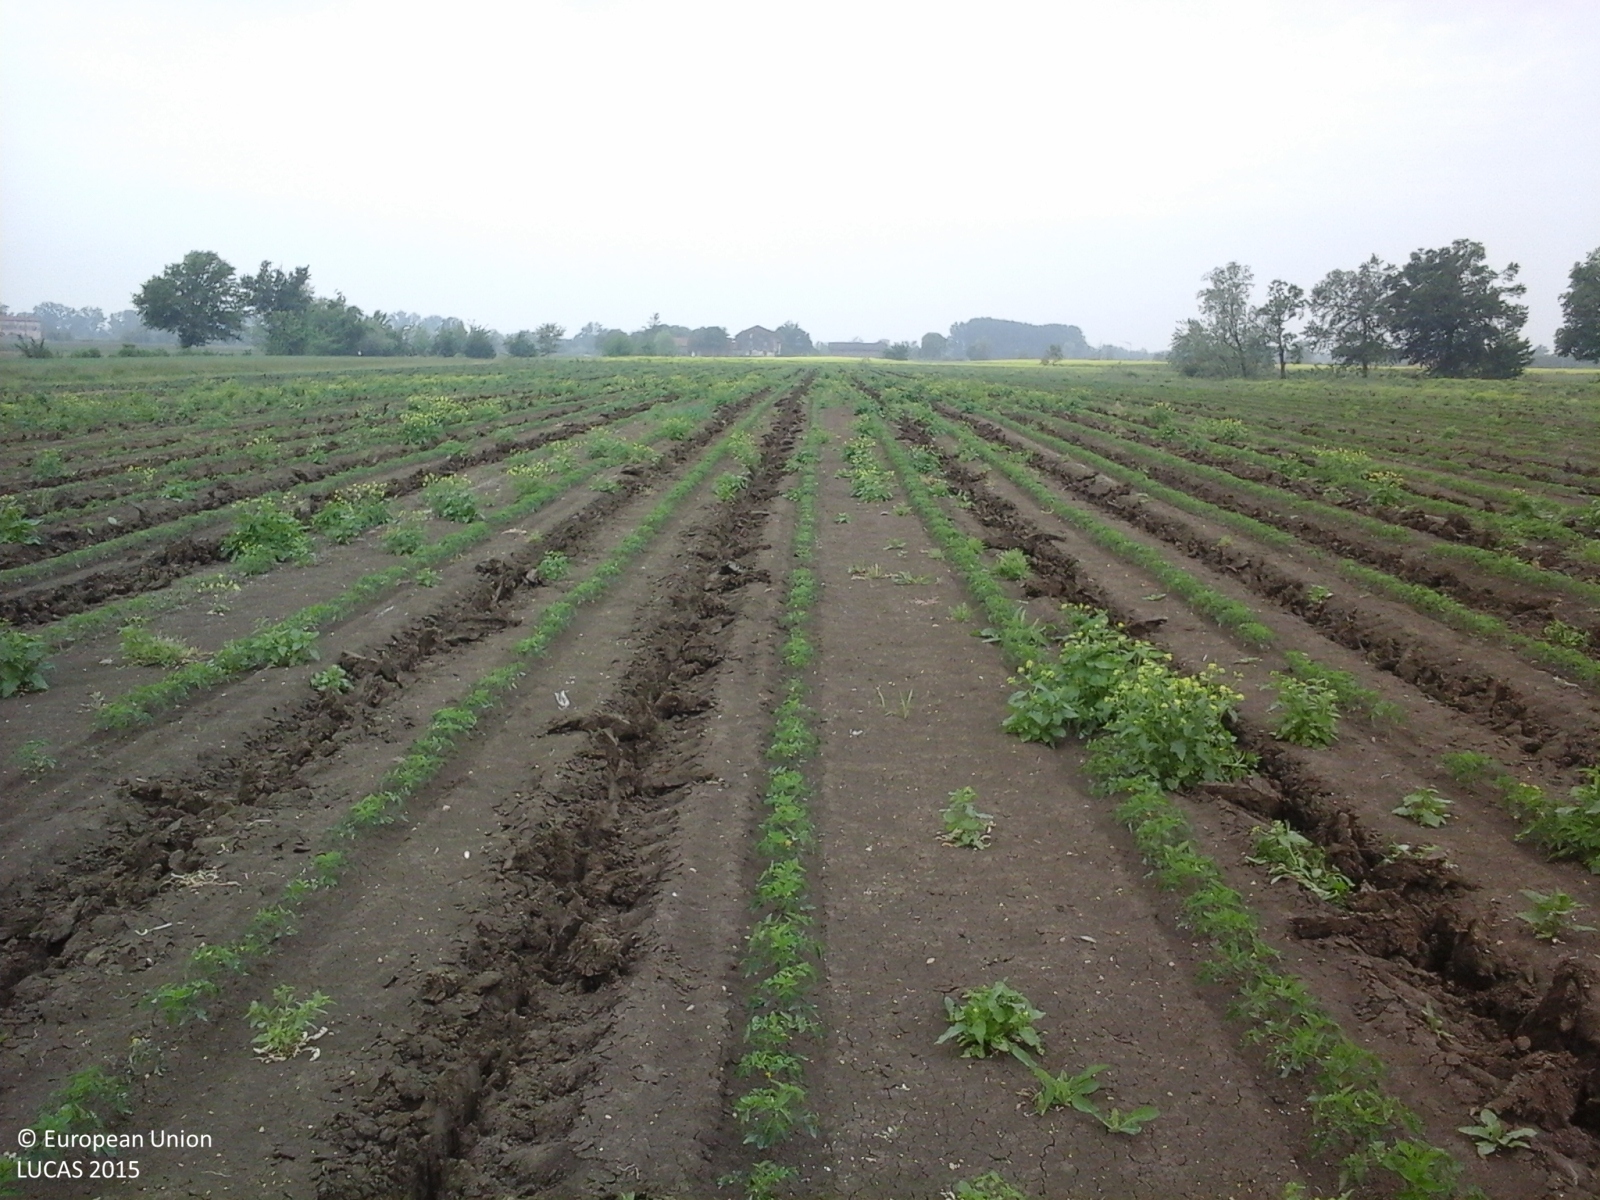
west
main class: Cropland
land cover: Tomatoes
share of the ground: 10 - 25 %
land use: Agriculture (excluding fallow land and kitchen gardens)
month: May
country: IT
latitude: 45.0342
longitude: 10.5701
